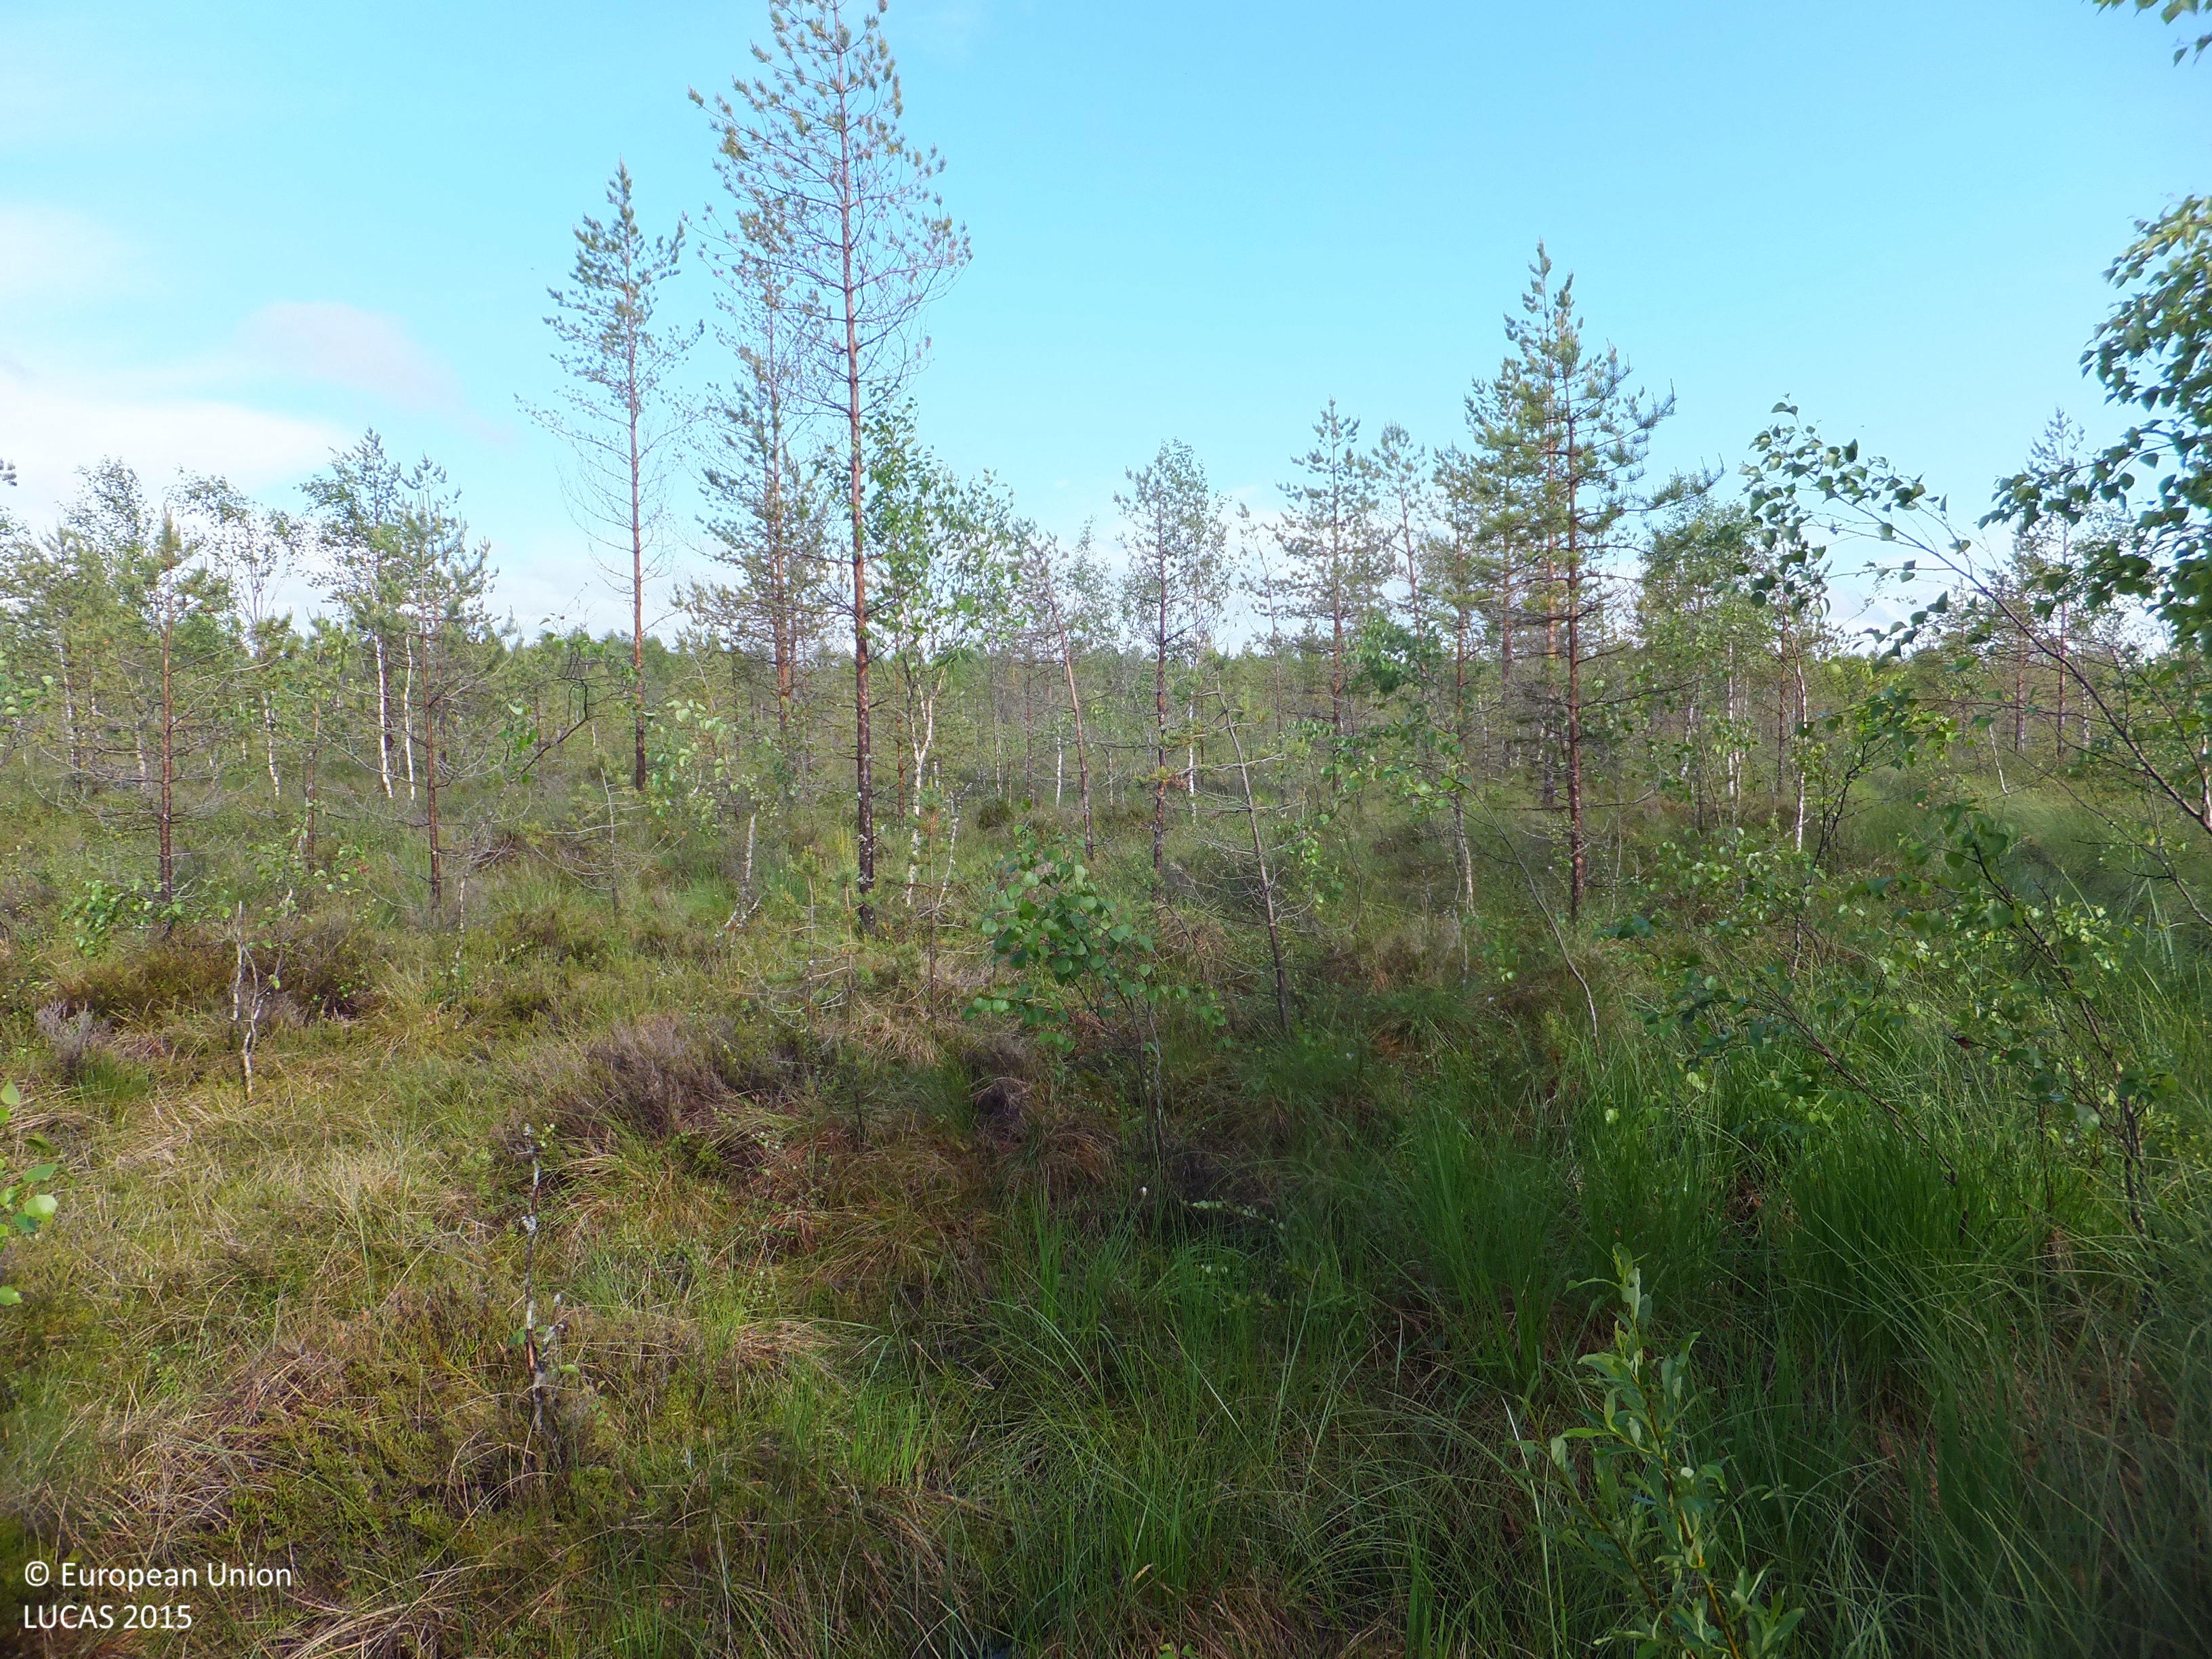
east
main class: Woodland
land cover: Broadleaved woodland
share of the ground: 25 - 50 %
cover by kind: broadleaved forest trees 30 %, herbaceous plants 30 %, shrubs 20 %, lichens and mosses 10 %
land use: Semi-natural and natural areas not in use
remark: Temporary flooded
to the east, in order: Broadleaved woodland; Pine dominated mixed woodland; Ditches and canals; Pine dominated mixed woodland; Ditches and canals; Pine dominated mixed woodland; Ditches and canals; Lines of trees; Ditches and canals; Pine dominated mixed woodland; Ditches and canals; Pine dominated mixed woodland; Ditches and canals; Pine dominated mixed woodland; Ditches and canals; Lines of trees; Ditches and canals; Pine dominated mixed woodland; Ditches and canals; Broadleaved woodland; Ditches and canals; Pine dominated mixed woodland; Ditches and canals; Pine dominated mixed woodland
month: June
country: FI
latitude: 63.4325
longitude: 24.6941
